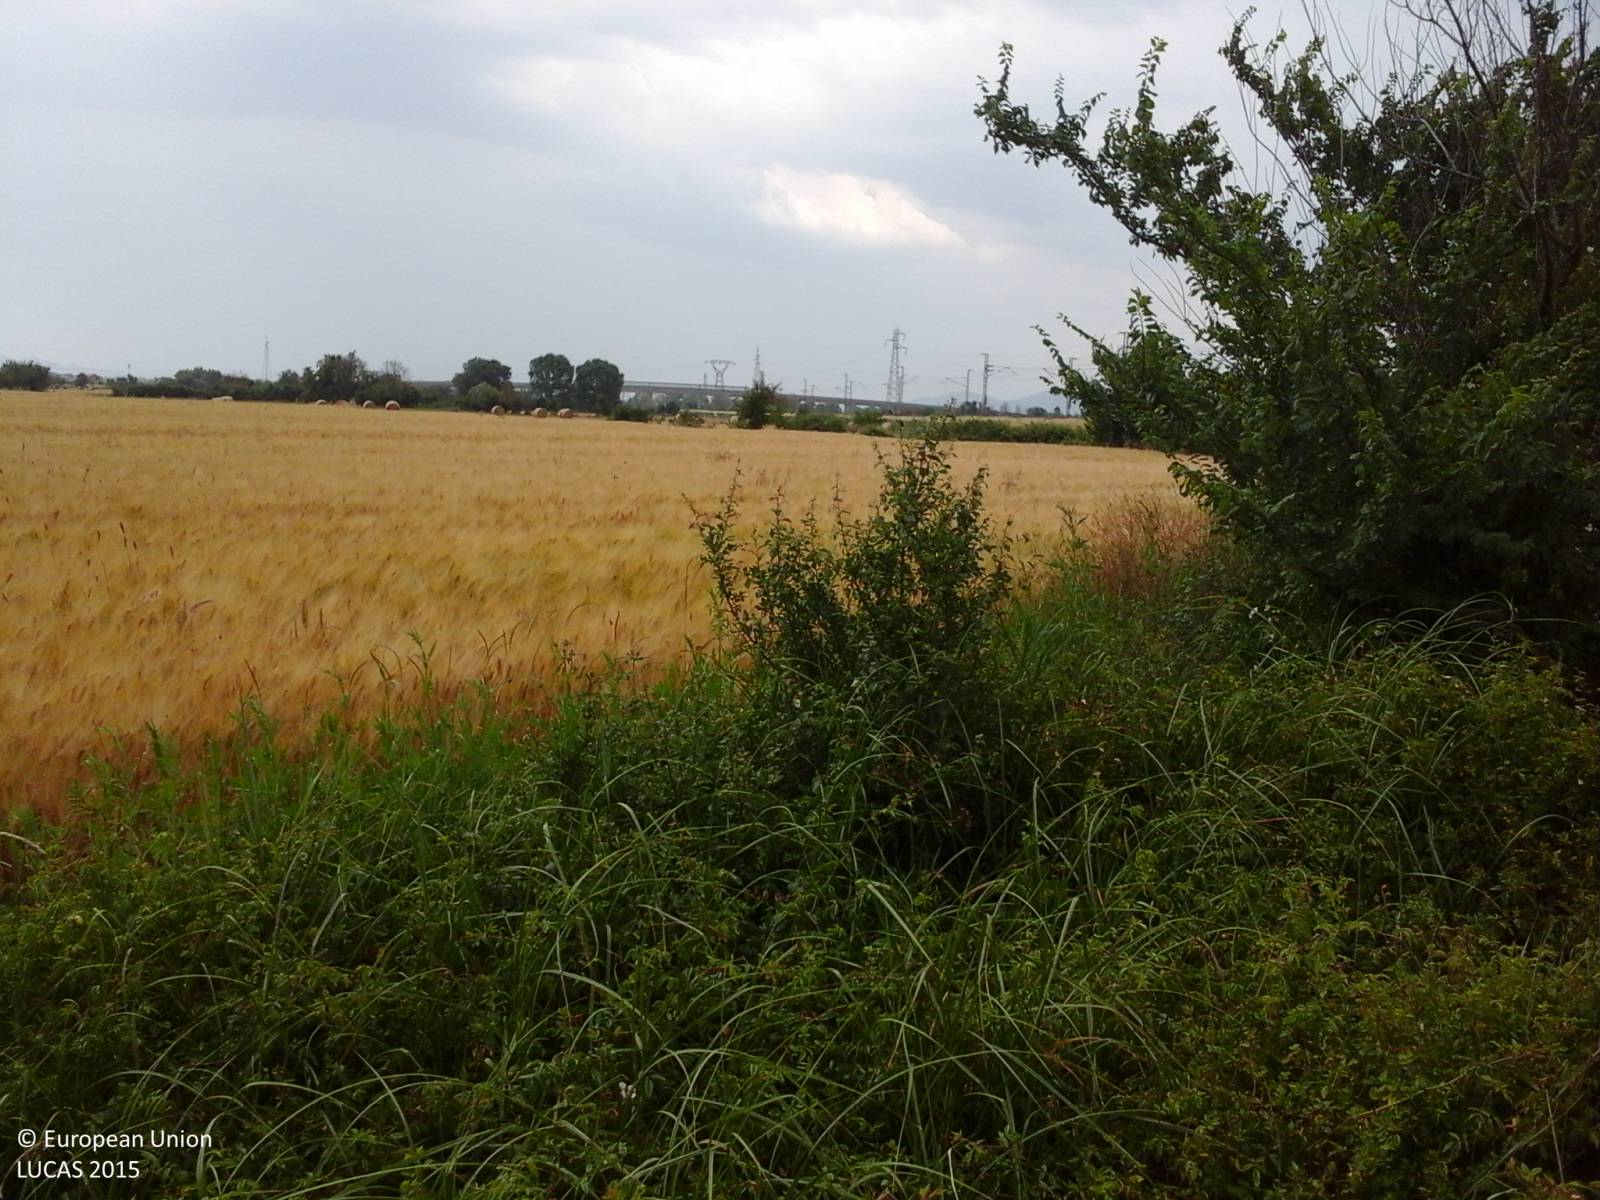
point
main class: Cropland
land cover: Barley
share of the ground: > 75 %
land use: Agriculture (excluding fallow land and kitchen gardens)
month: June
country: IT
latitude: 41.0838
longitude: 14.1852
